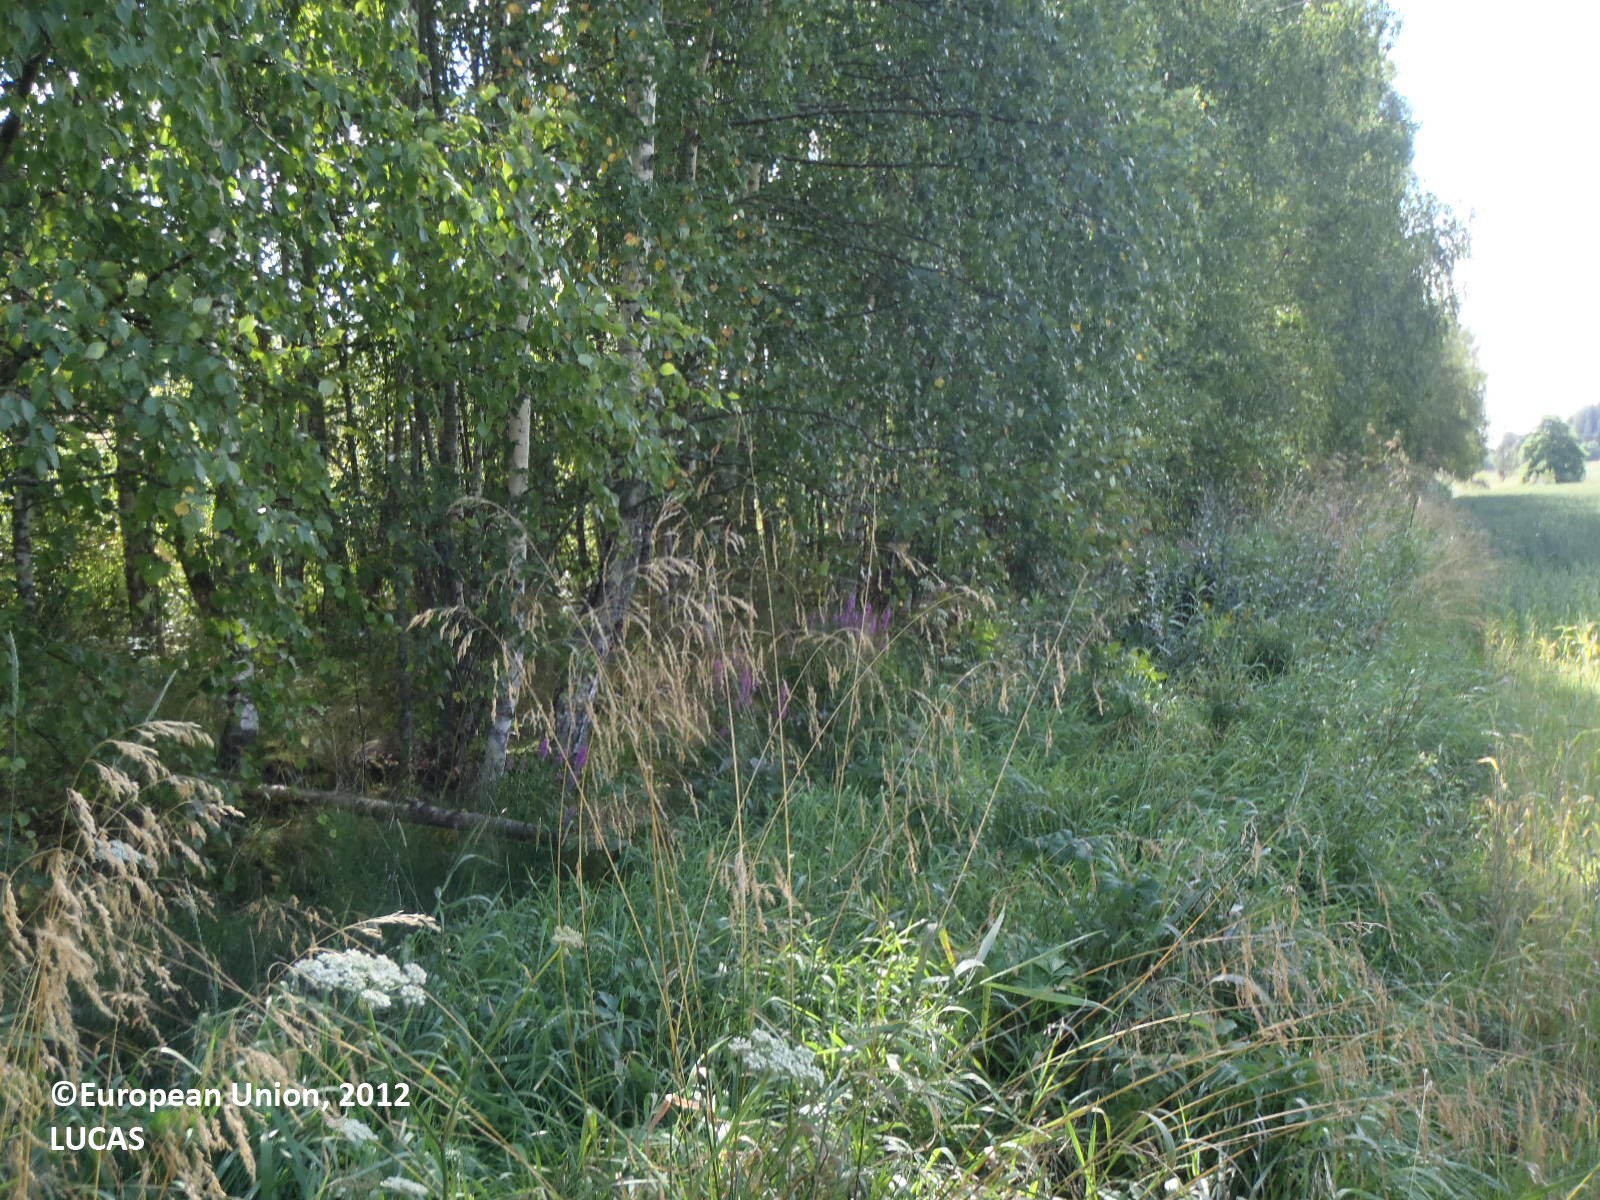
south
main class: Cropland
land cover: Common wheat
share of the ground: > 75 %
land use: Agriculture (excluding fallow land and kitchen gardens)
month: August
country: FI
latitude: 60.3423
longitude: 22.4079
